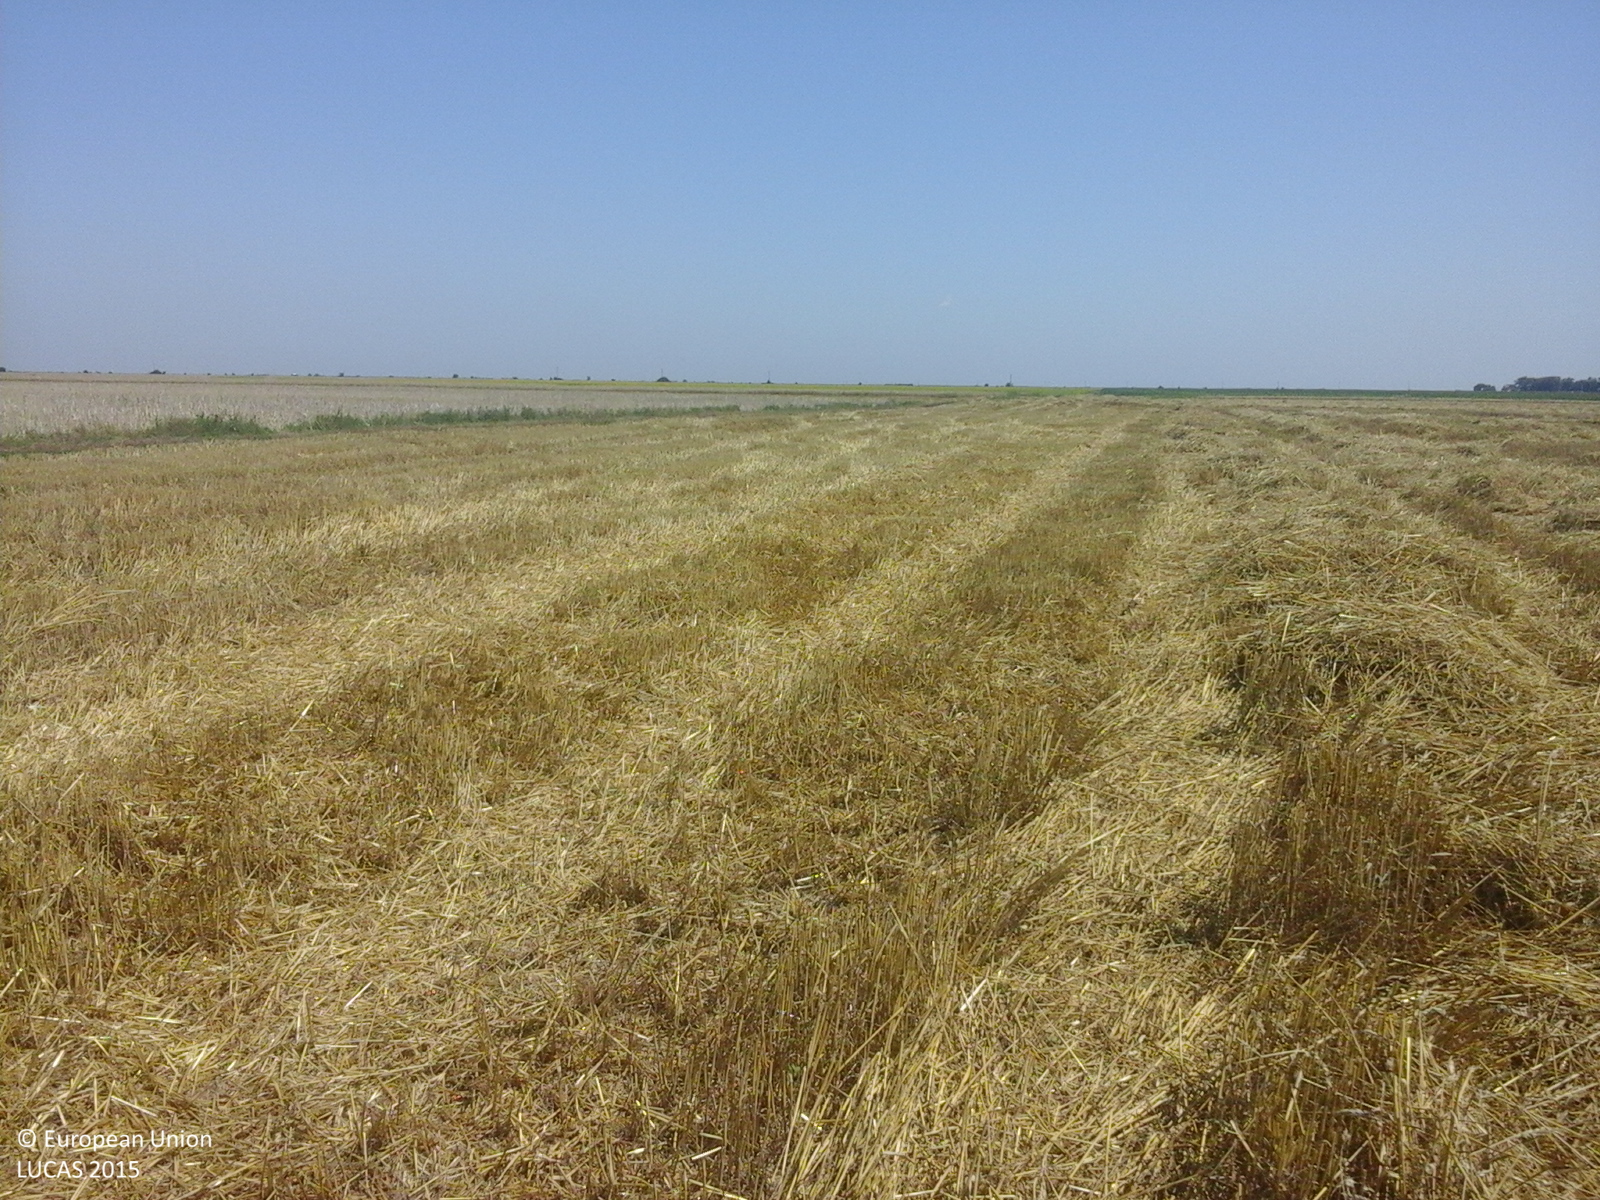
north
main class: Cropland
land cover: Common wheat
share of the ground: < 10 %
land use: Agriculture (excluding fallow land and kitchen gardens)
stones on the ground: < 10 %
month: July
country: RO
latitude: 44.1901
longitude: 24.3402
